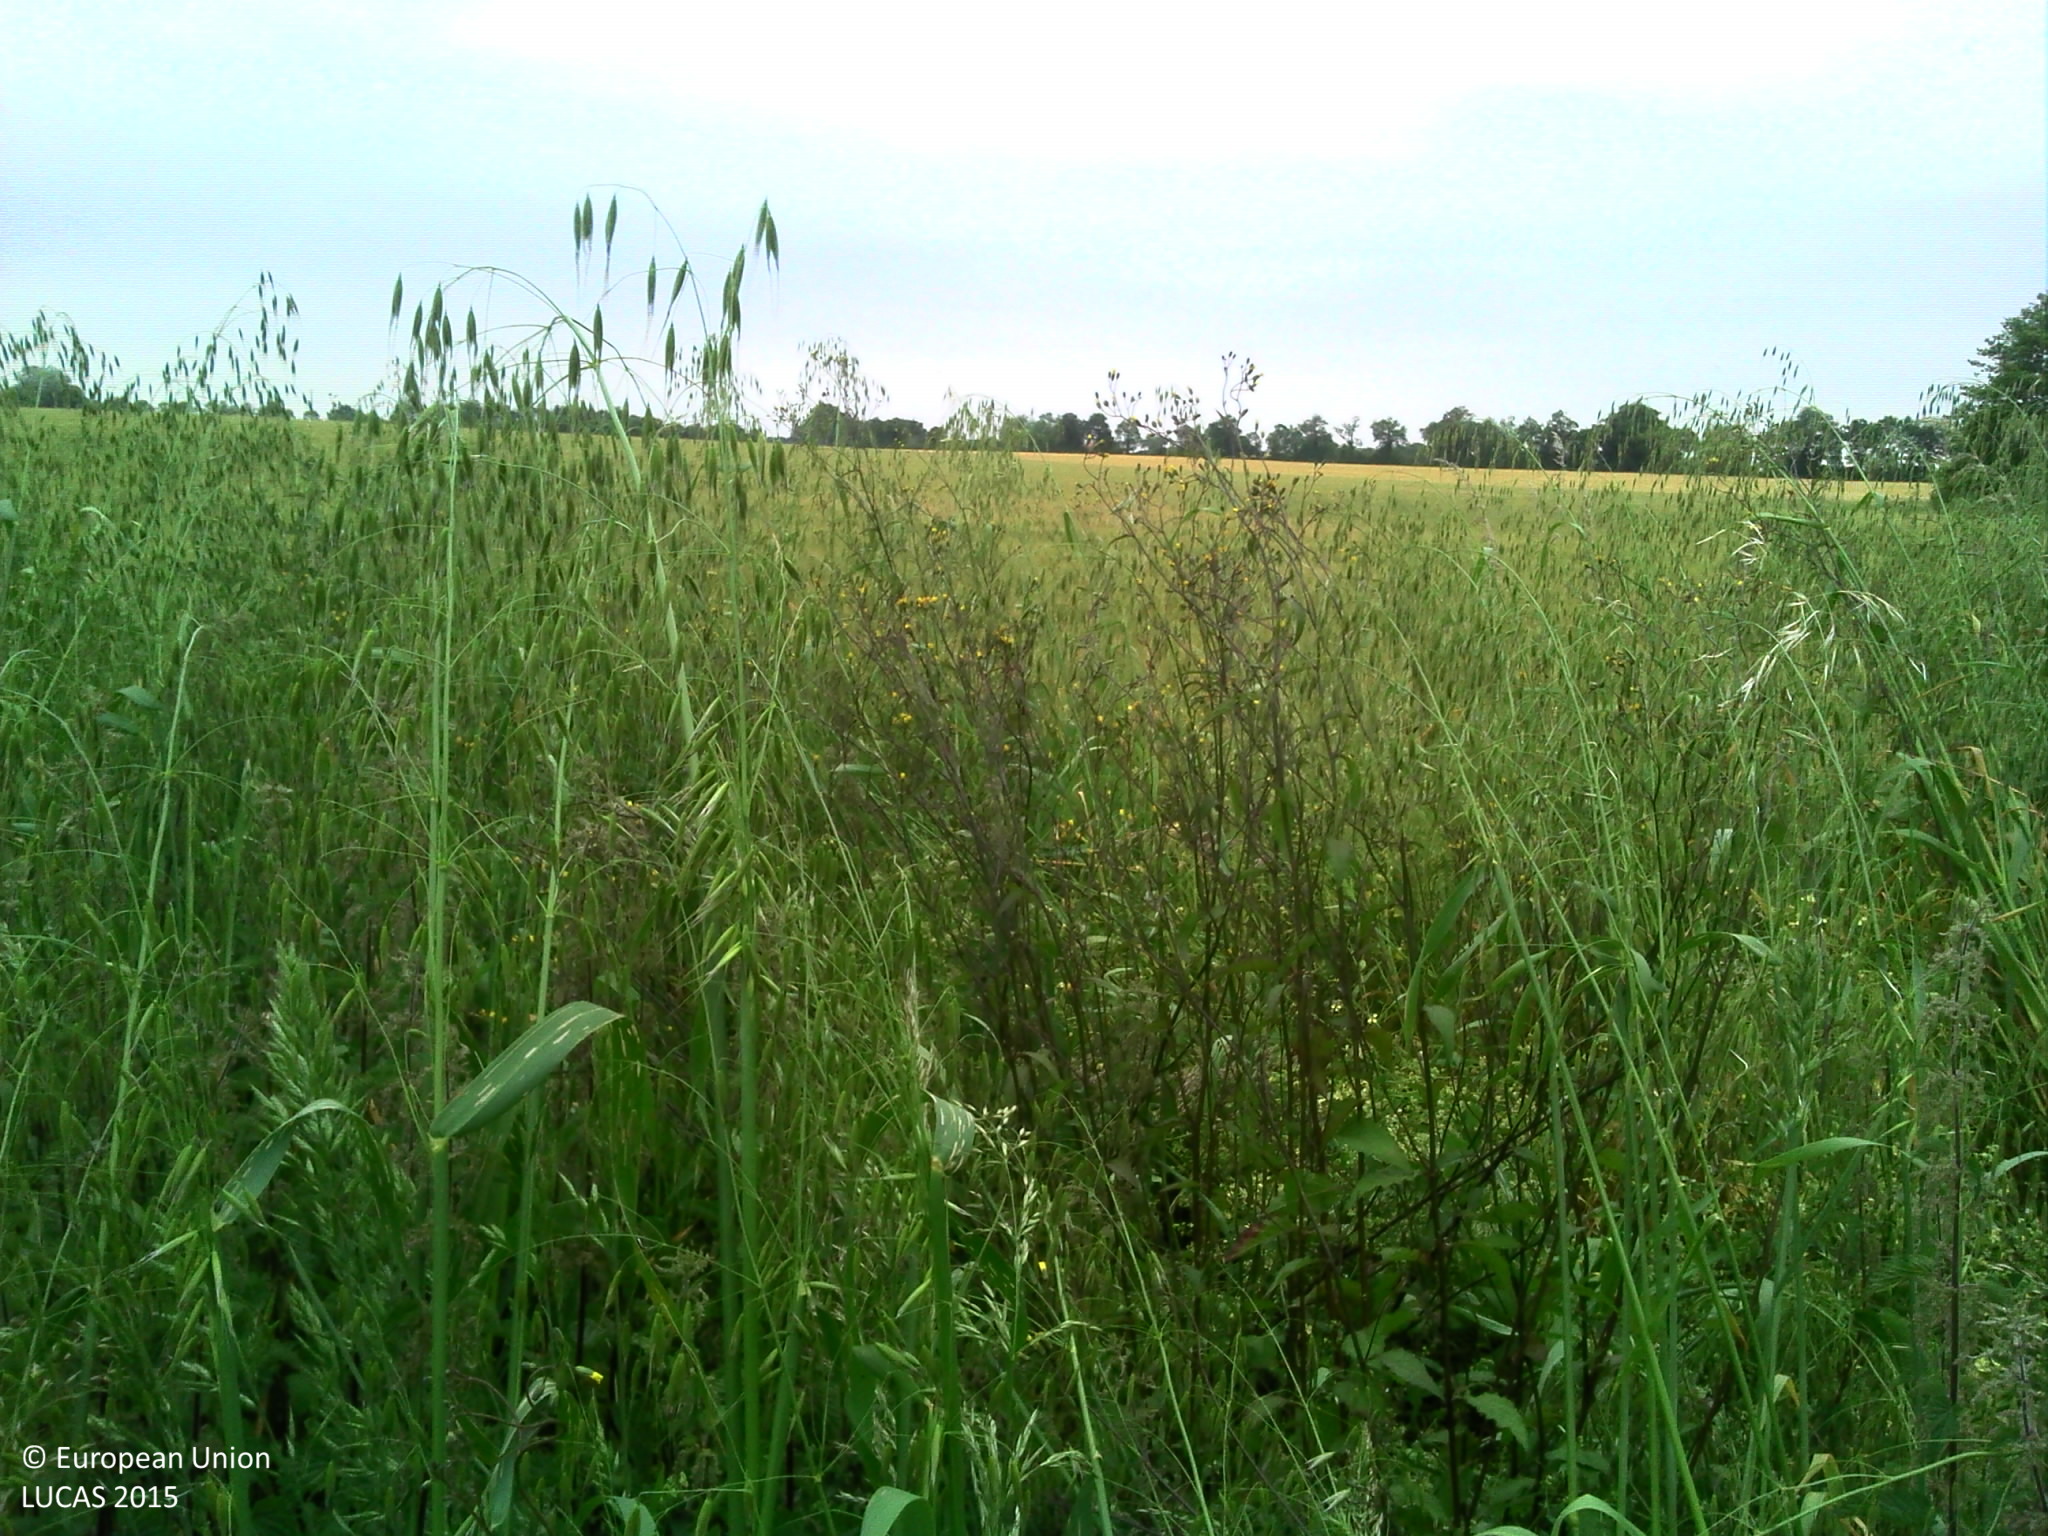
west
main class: Cropland
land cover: Common wheat
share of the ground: > 75 %
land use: Agriculture (excluding fallow land and kitchen gardens)
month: June
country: FR
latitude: 46.9665
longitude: -1.4875
